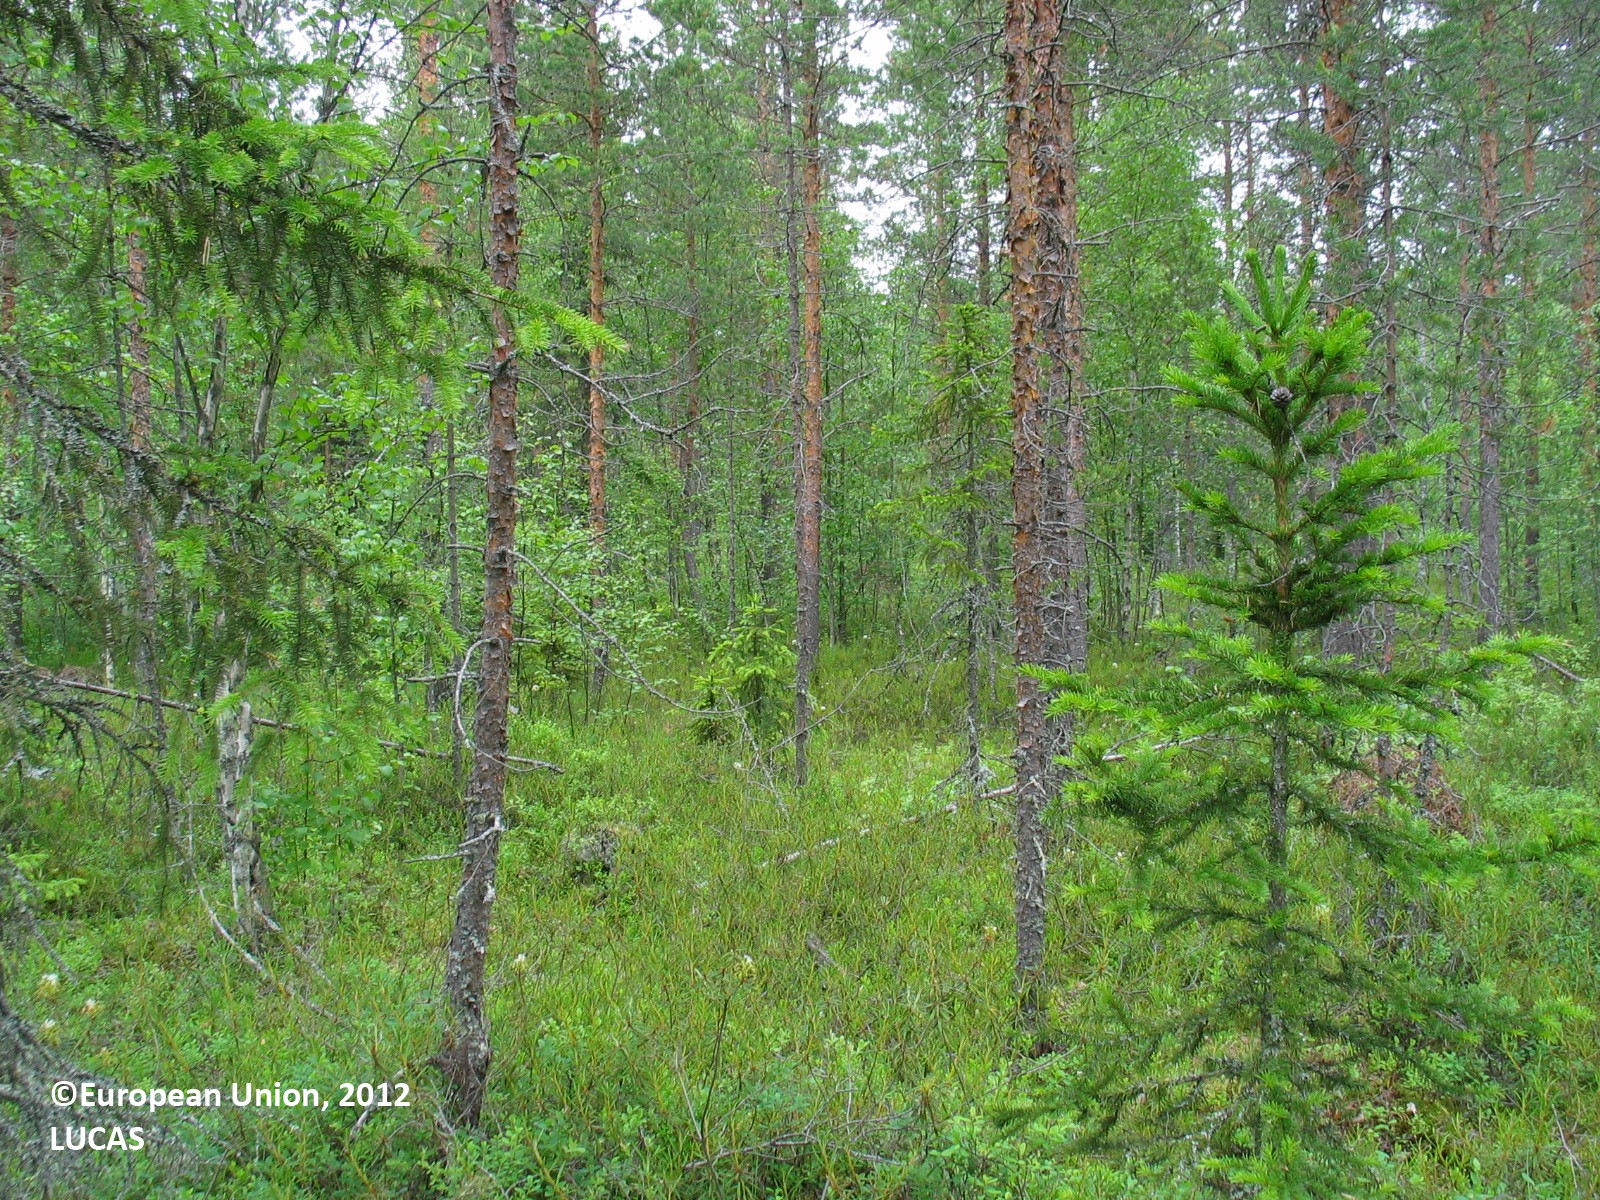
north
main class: Woodland
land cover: Pine dominated coniferous woodland
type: mire and swamp forests
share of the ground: 25 - 50 %
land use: Forestry
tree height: > 5 m
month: July
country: FI
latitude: 64.6474
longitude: 26.5879
